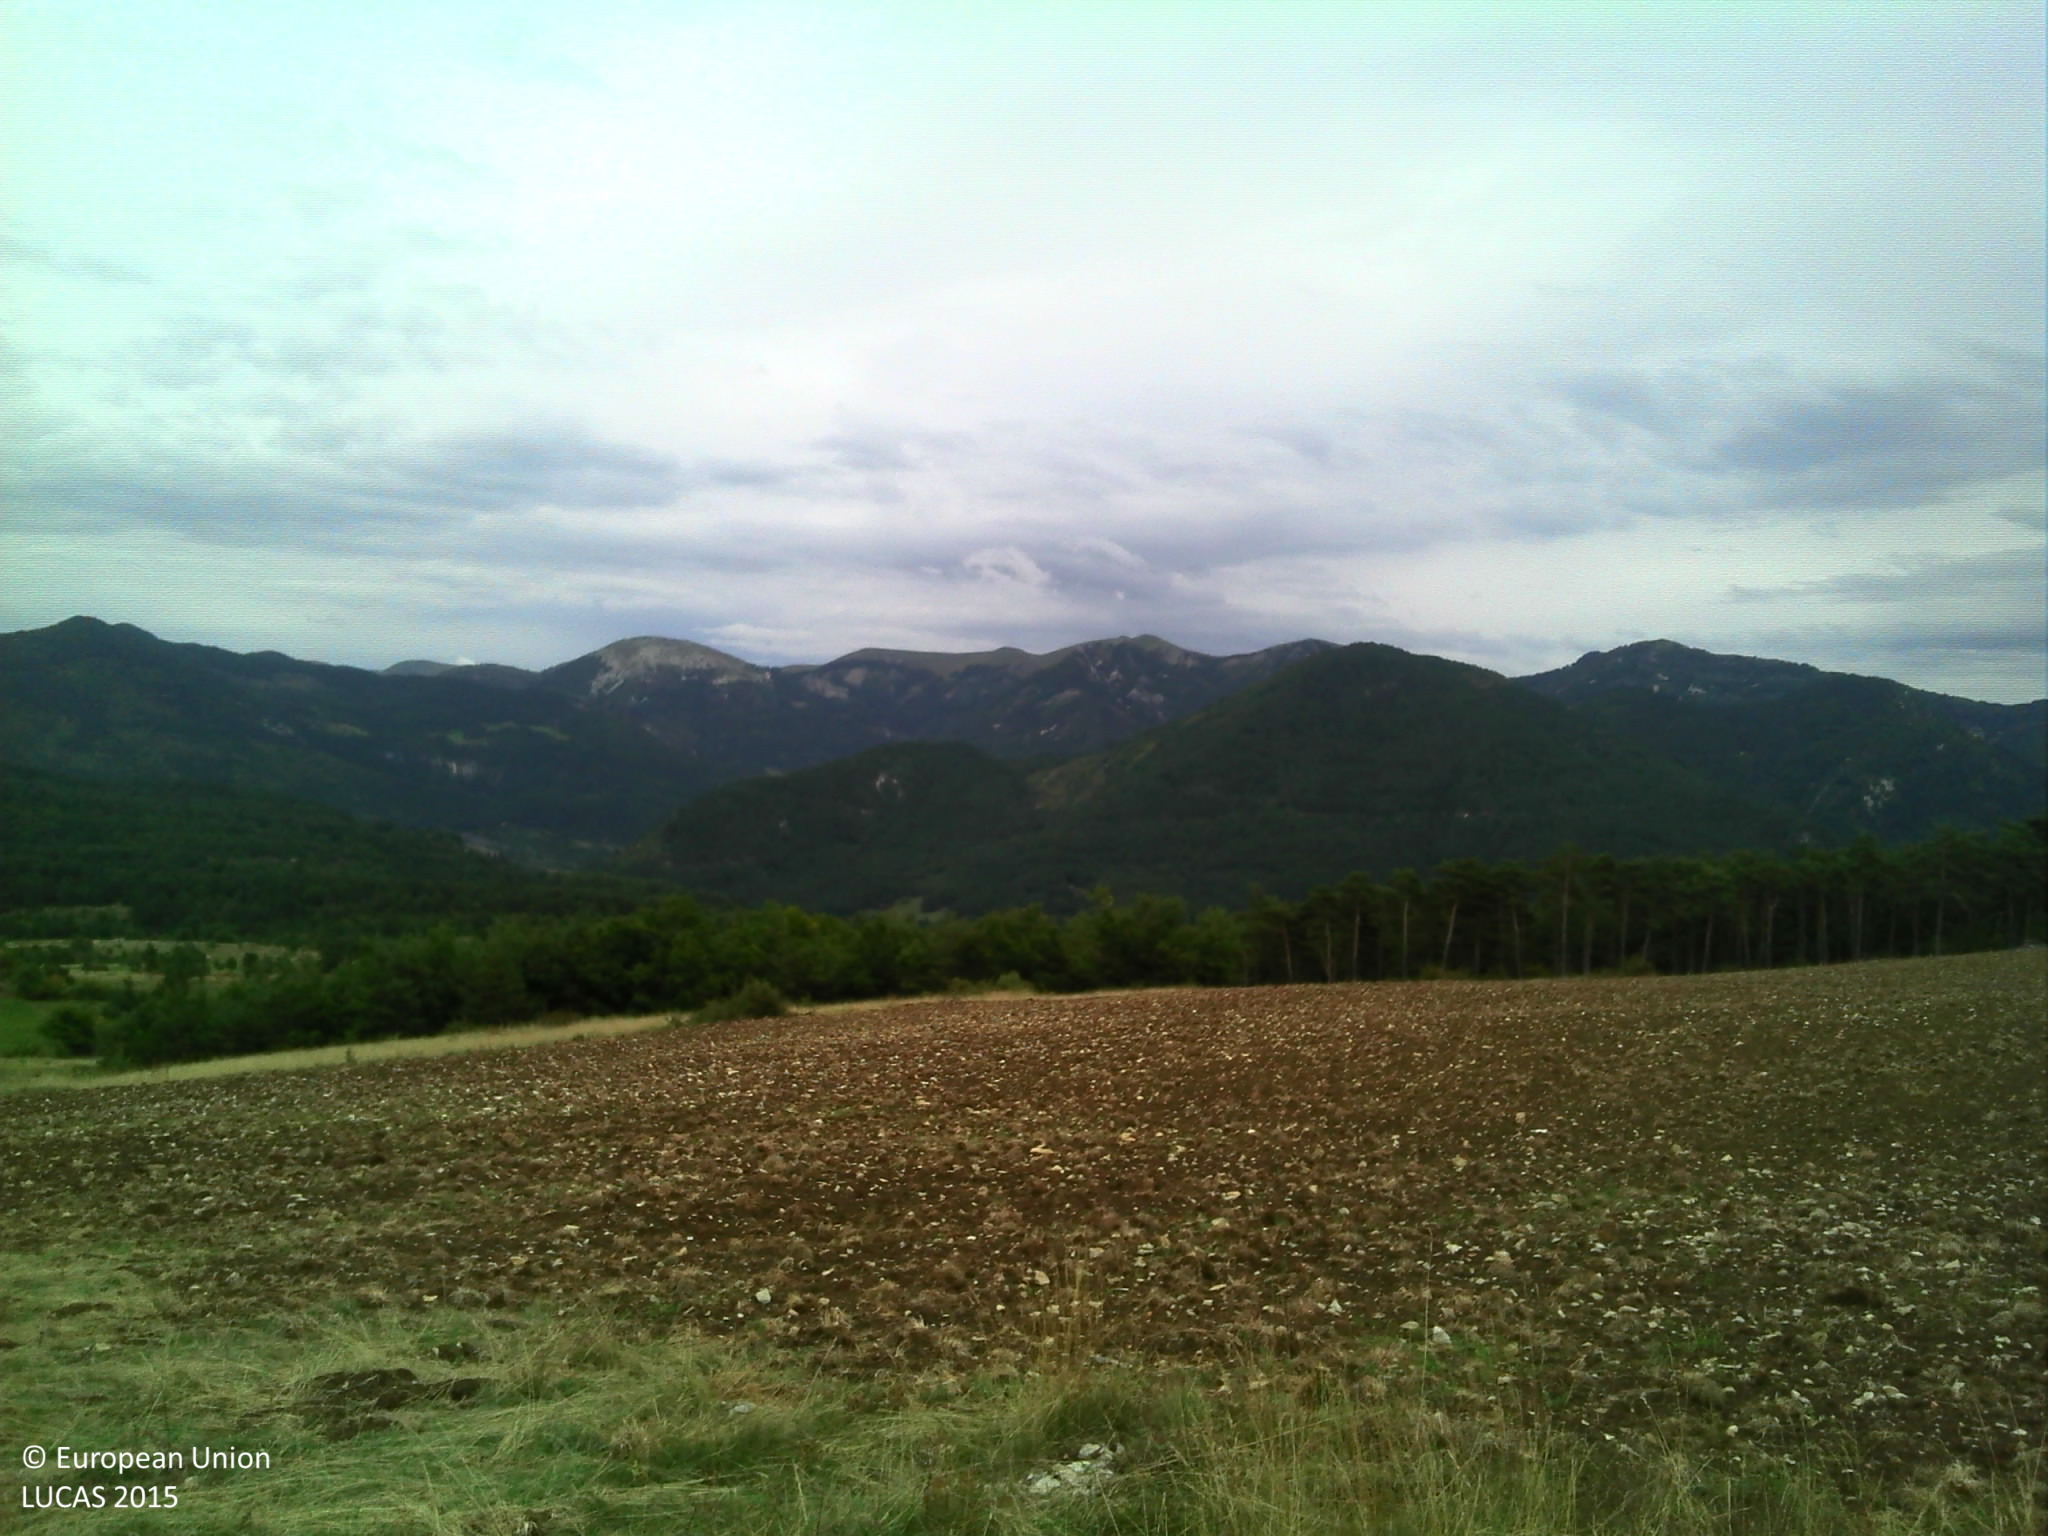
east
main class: Grassland
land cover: Grassland without tree/shrub cover
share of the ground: > 75 %
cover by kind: herbaceous plants 100 %
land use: Agriculture (excluding fallow land and kitchen gardens)
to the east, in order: Grassland without tree/shrub cover; Lucerne; Grassland without tree/shrub cover; Tracks; Grassland without tree/shrub cover; Pine dominated coniferous woodland
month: September
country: FR
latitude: 44.5796
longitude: 5.5359
